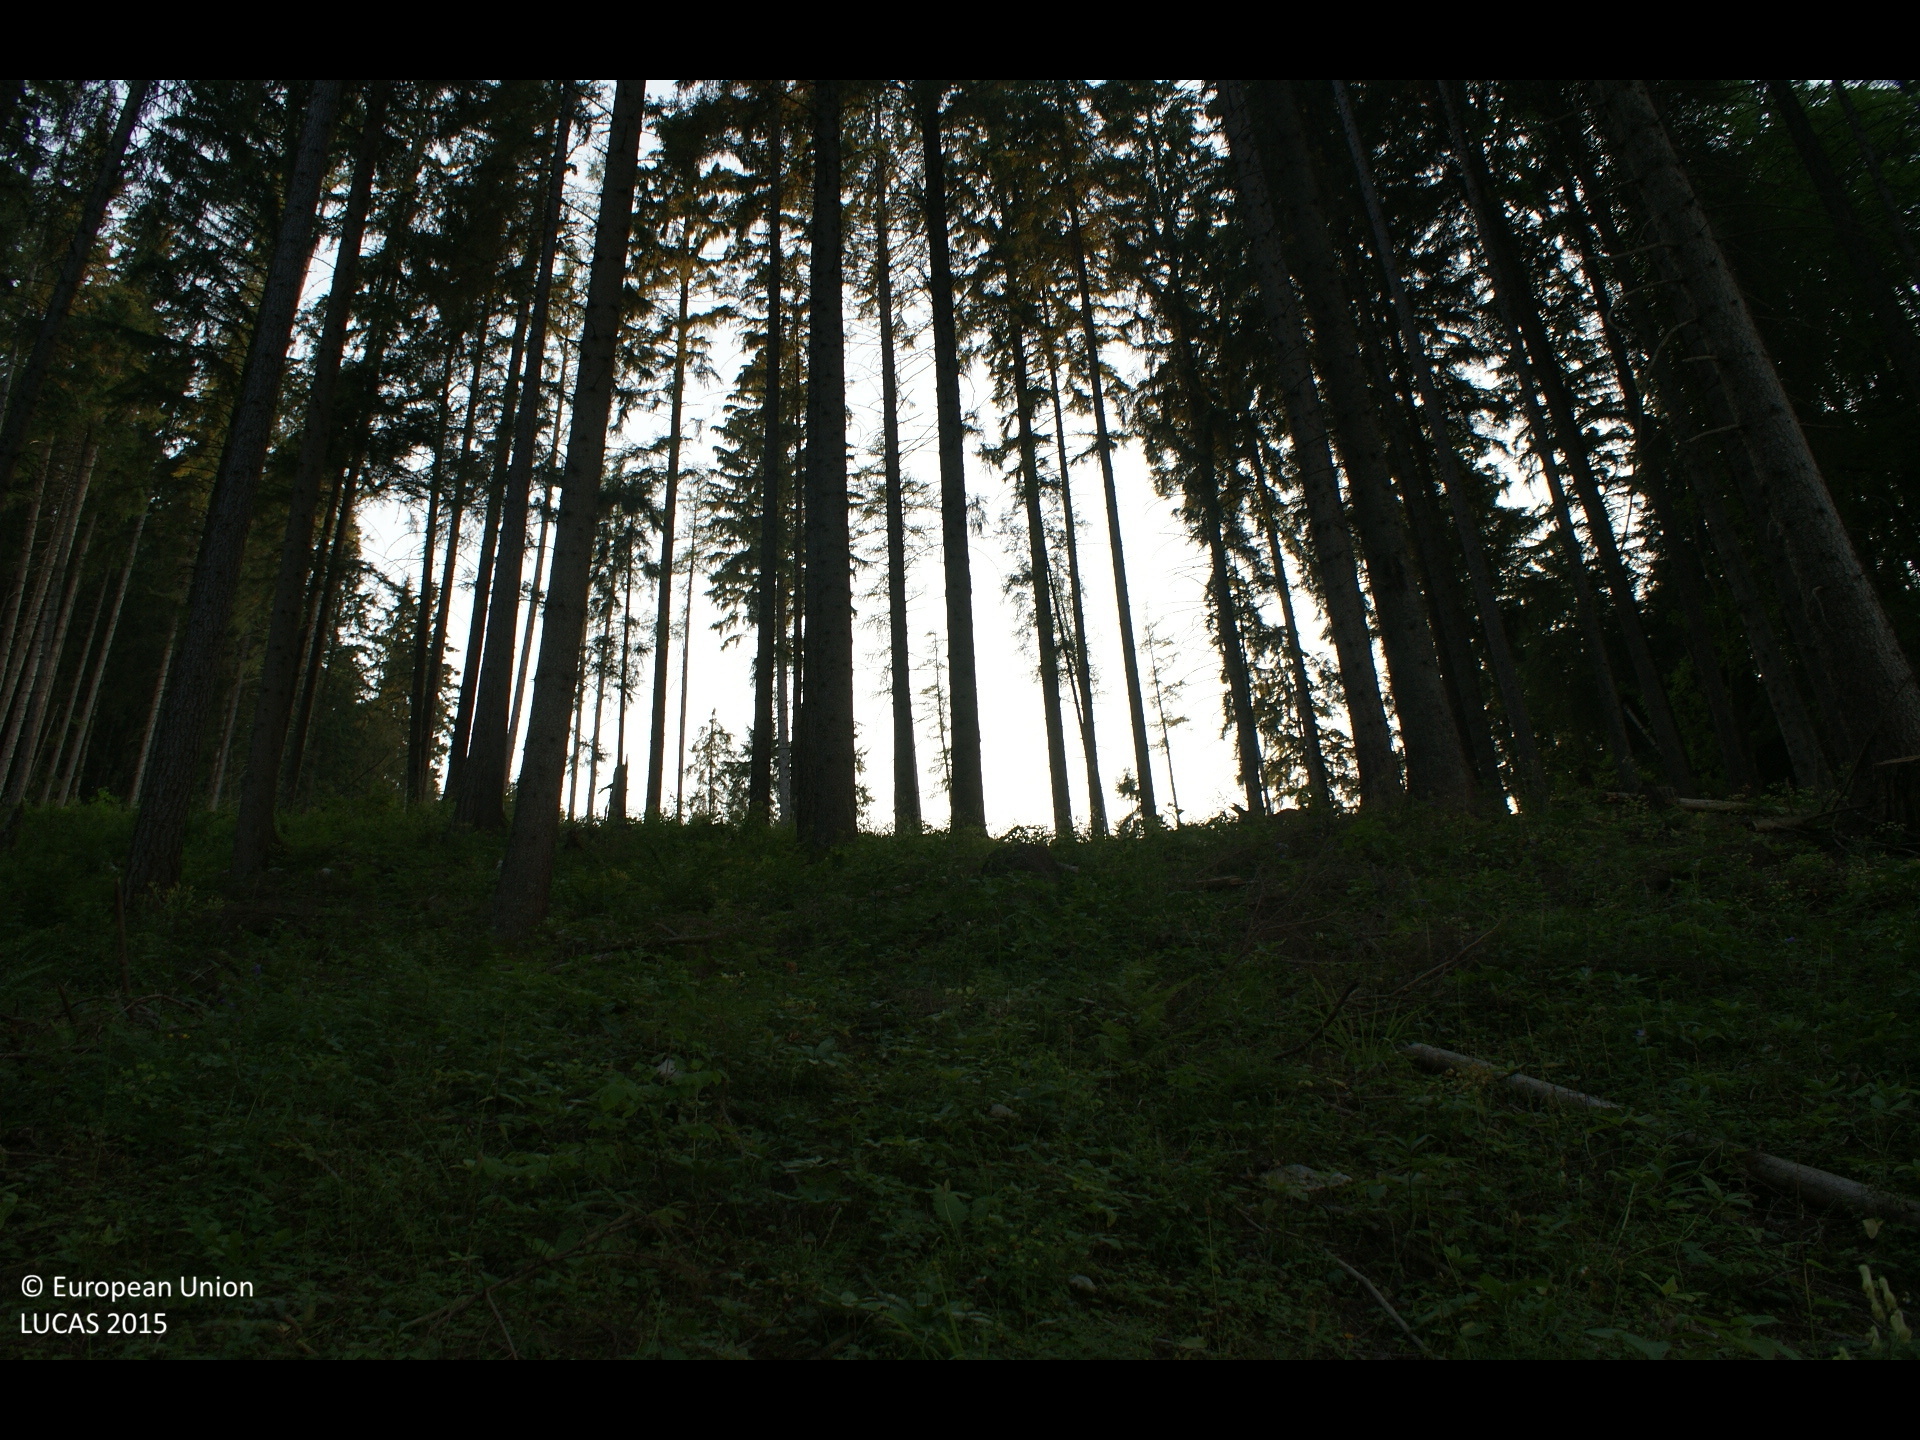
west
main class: Woodland
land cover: Spruce dominated coniferous woodland
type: alpine coniferous forest
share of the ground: 50 - 75 %
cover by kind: coniferous forest trees 70 %, herbaceous plants 30 %
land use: Forestry
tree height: > 5 m
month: July
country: AT
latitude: 47.7510
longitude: 15.3499
